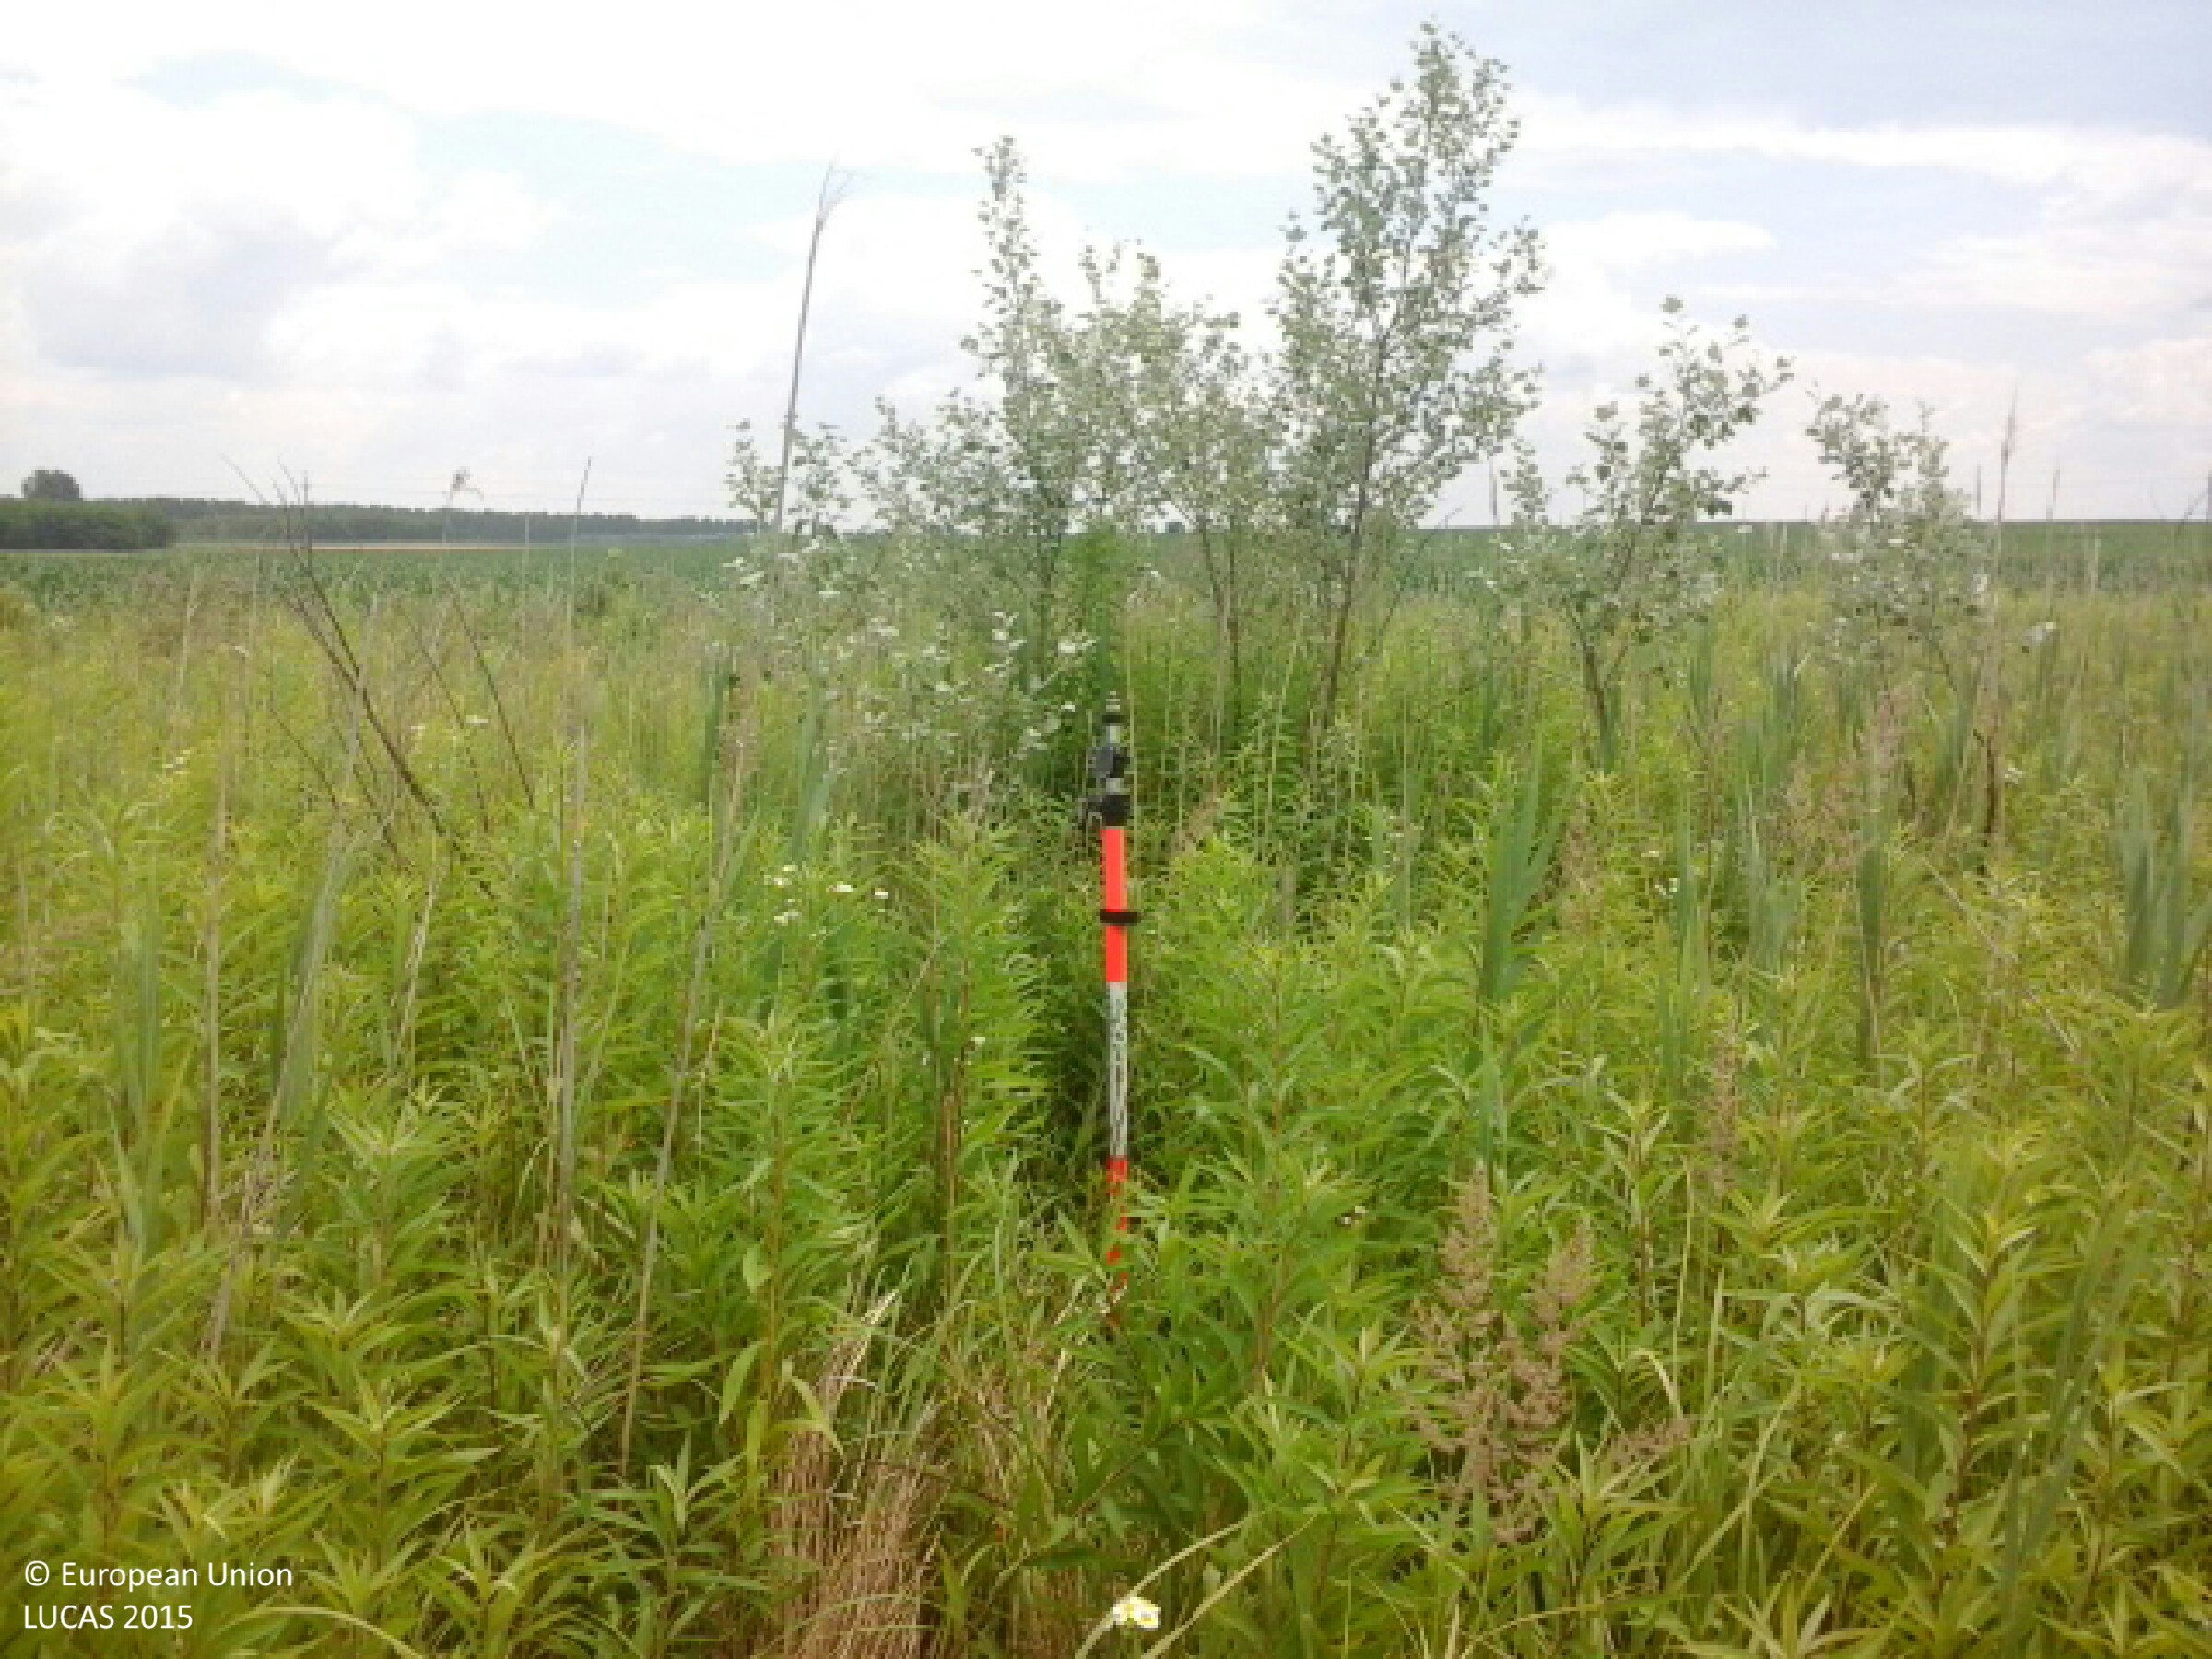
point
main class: Grassland
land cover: Spontaneously vegetated surfaces
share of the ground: > 75 %
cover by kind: herbaceous plants 95 %, shrubs 5 %
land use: Abandoned areas
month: June
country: HU
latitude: 48.1472
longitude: 22.0016
